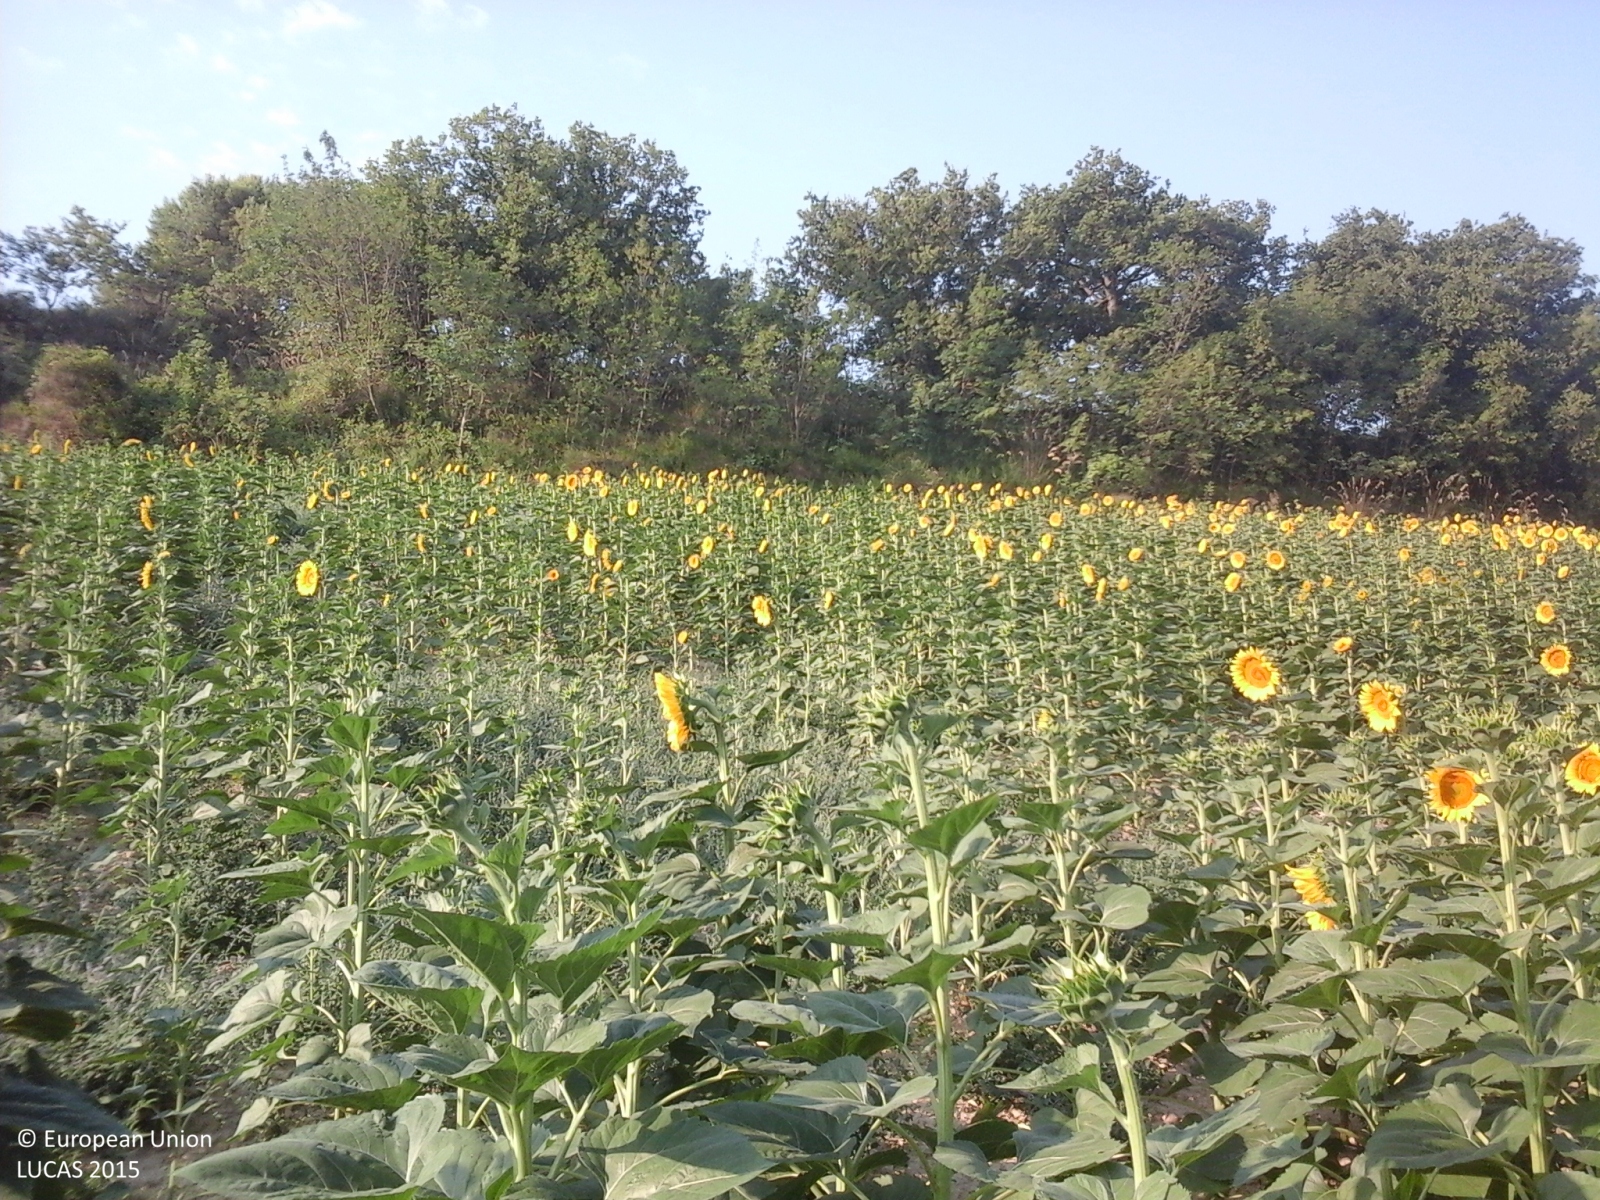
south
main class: Cropland
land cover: Sunflower
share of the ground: > 75 %
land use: Agriculture (excluding fallow land and kitchen gardens)
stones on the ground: < 10 %
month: July
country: IT
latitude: 43.0704
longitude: 13.8093
